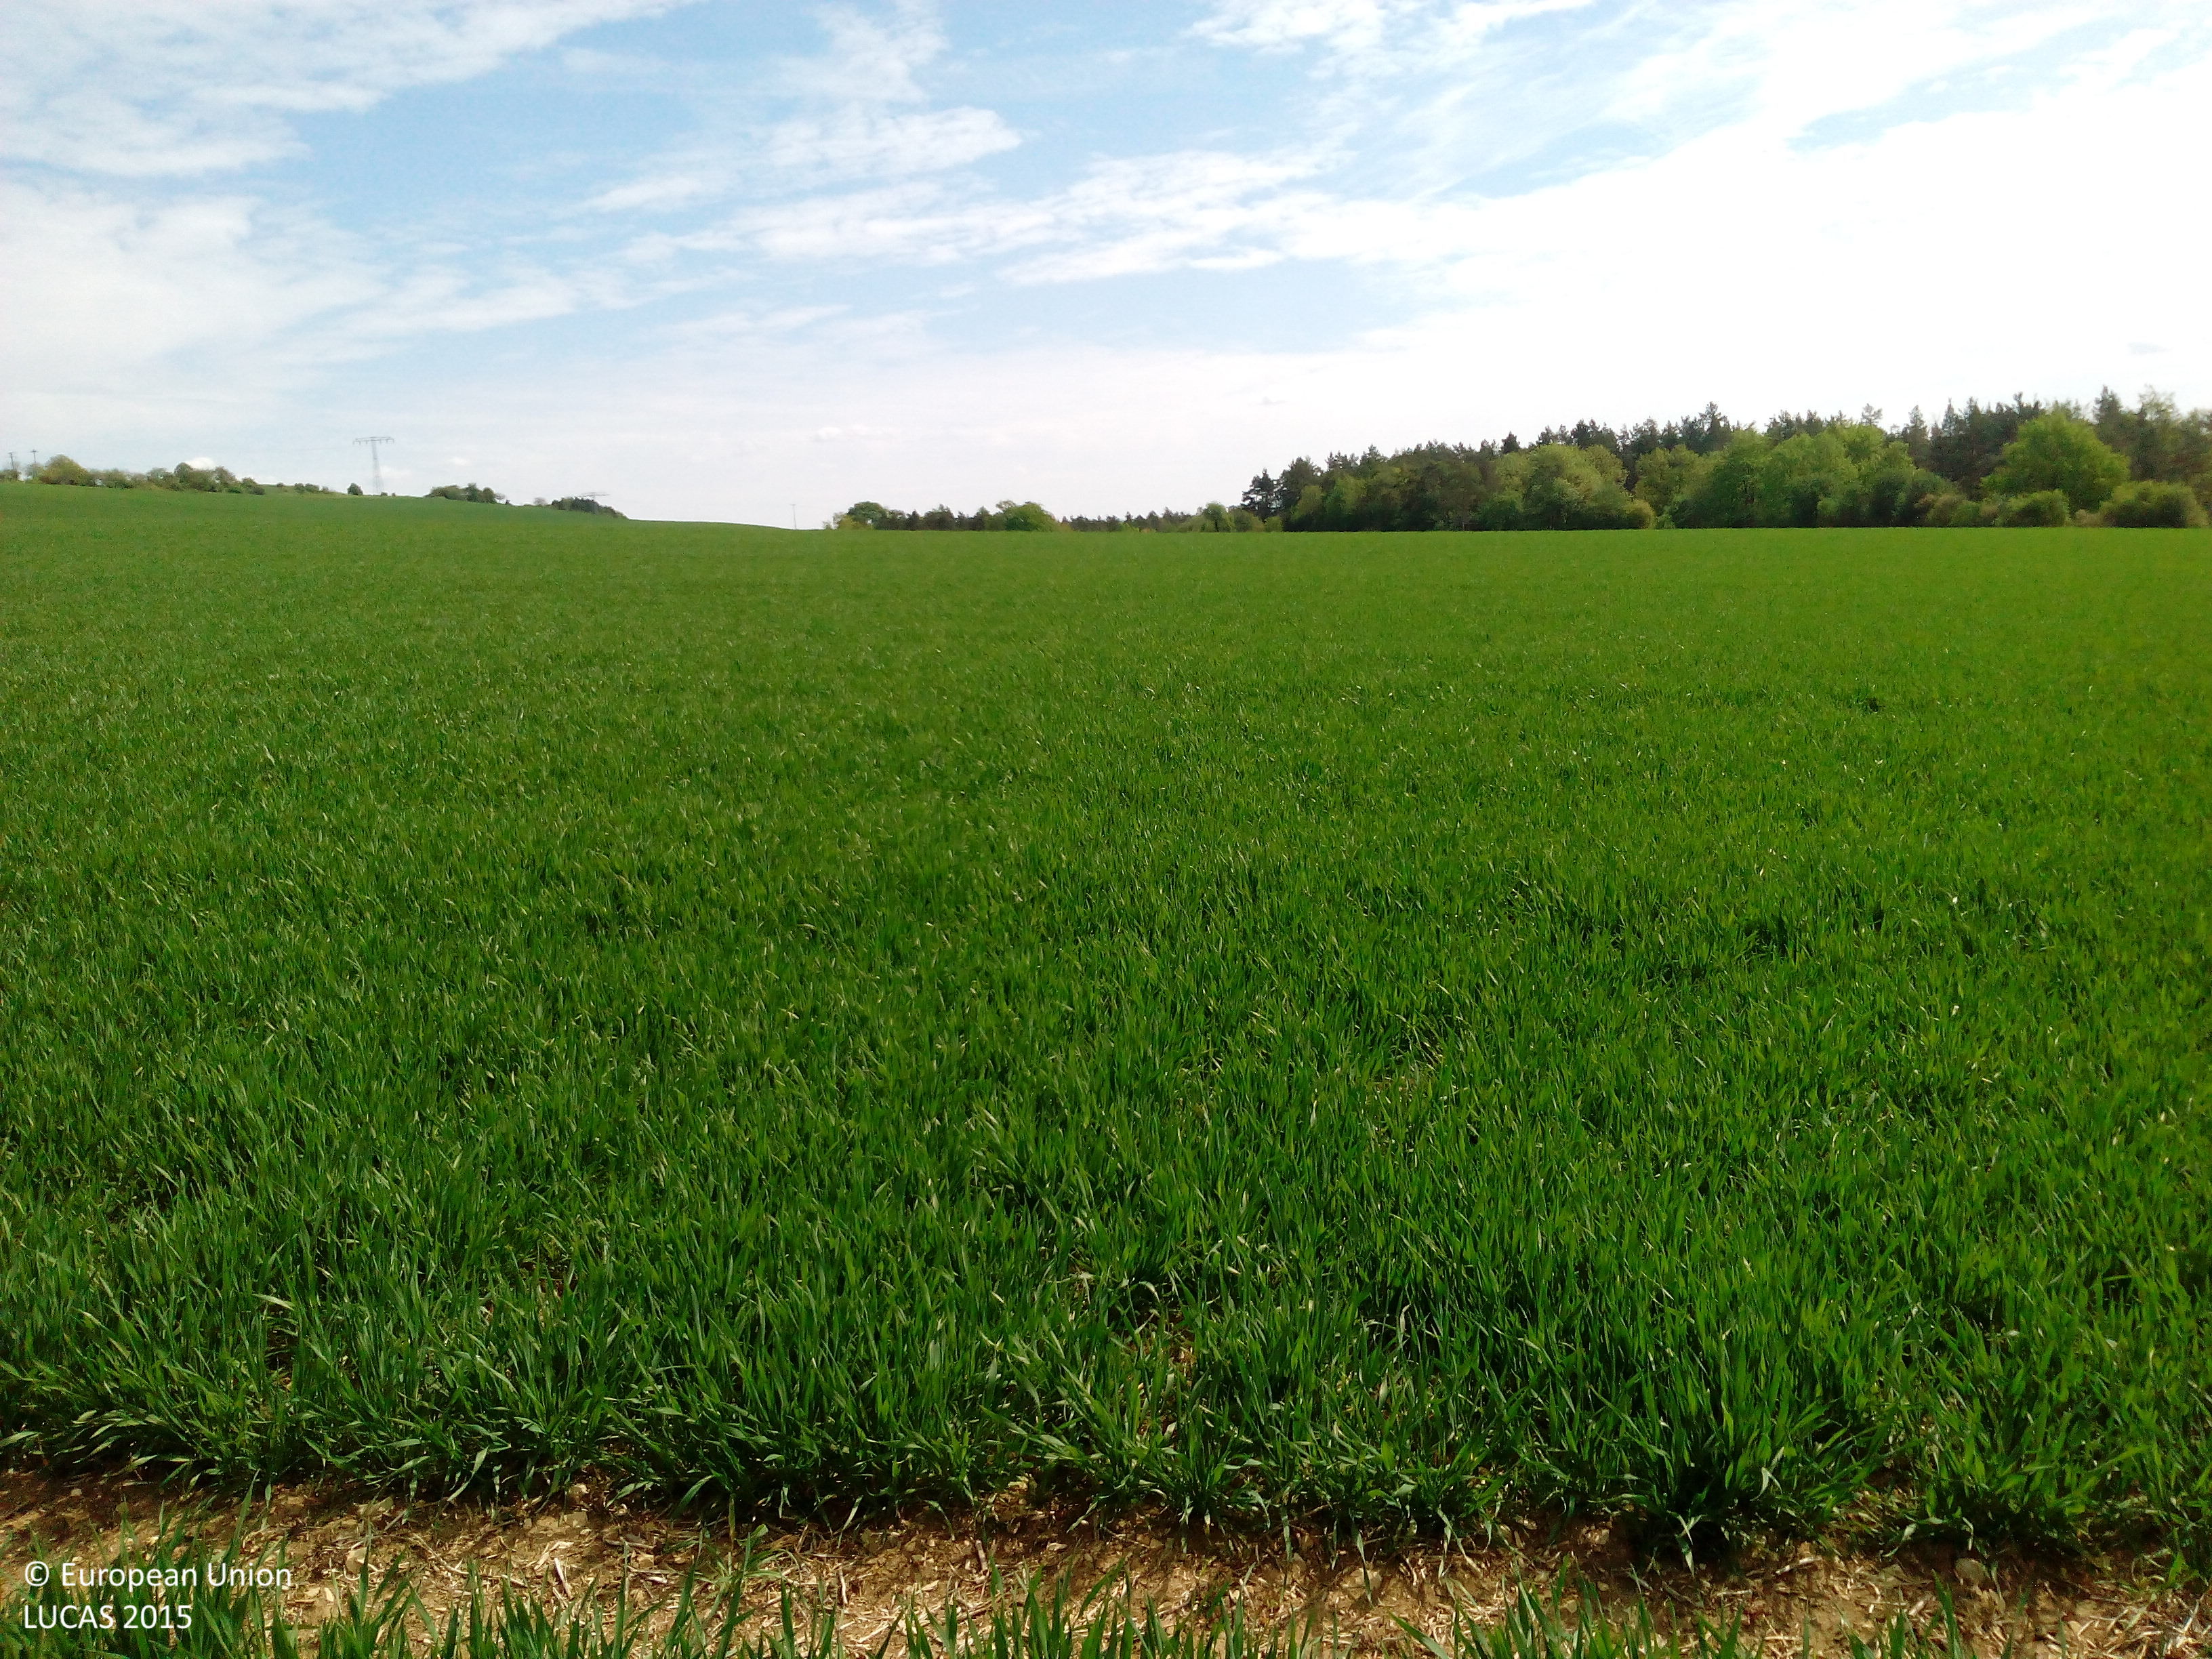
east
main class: Cropland
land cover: Common wheat
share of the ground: > 75 %
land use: Agriculture (excluding fallow land and kitchen gardens)
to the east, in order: Common wheat
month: May
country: DE
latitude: 50.8934
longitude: 11.5209
